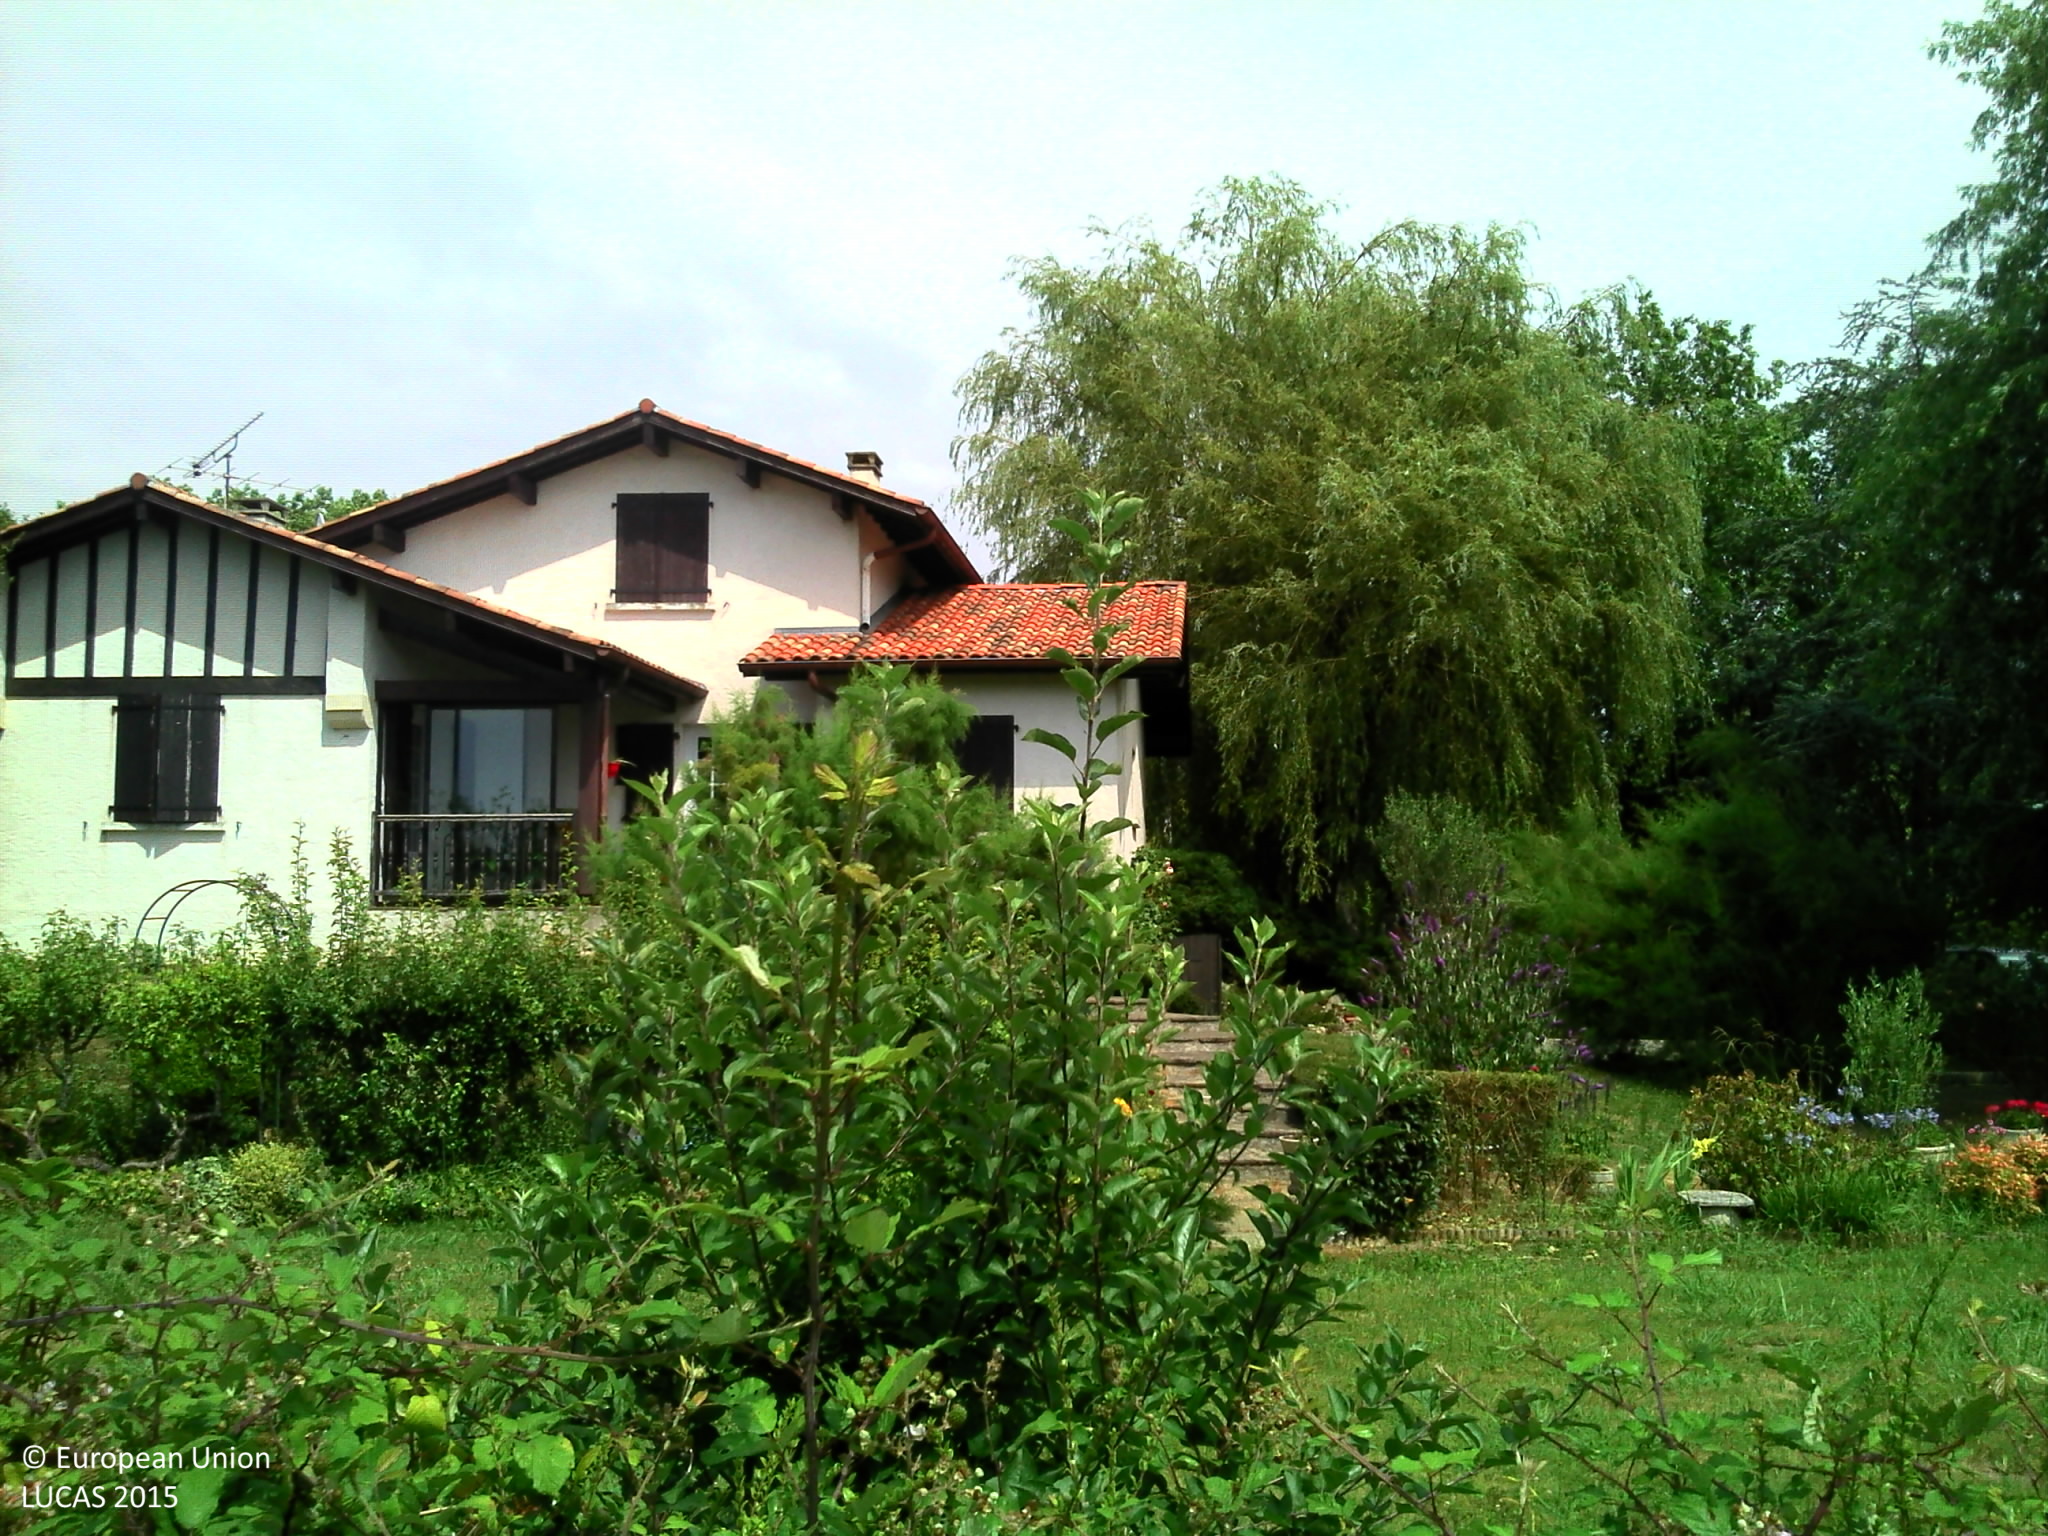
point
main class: Grassland
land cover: Grassland without tree/shrub cover
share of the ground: > 75 %
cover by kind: herbaceous plants 100 %
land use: Residential
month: July
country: FR
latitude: 43.5857
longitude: -1.3000
